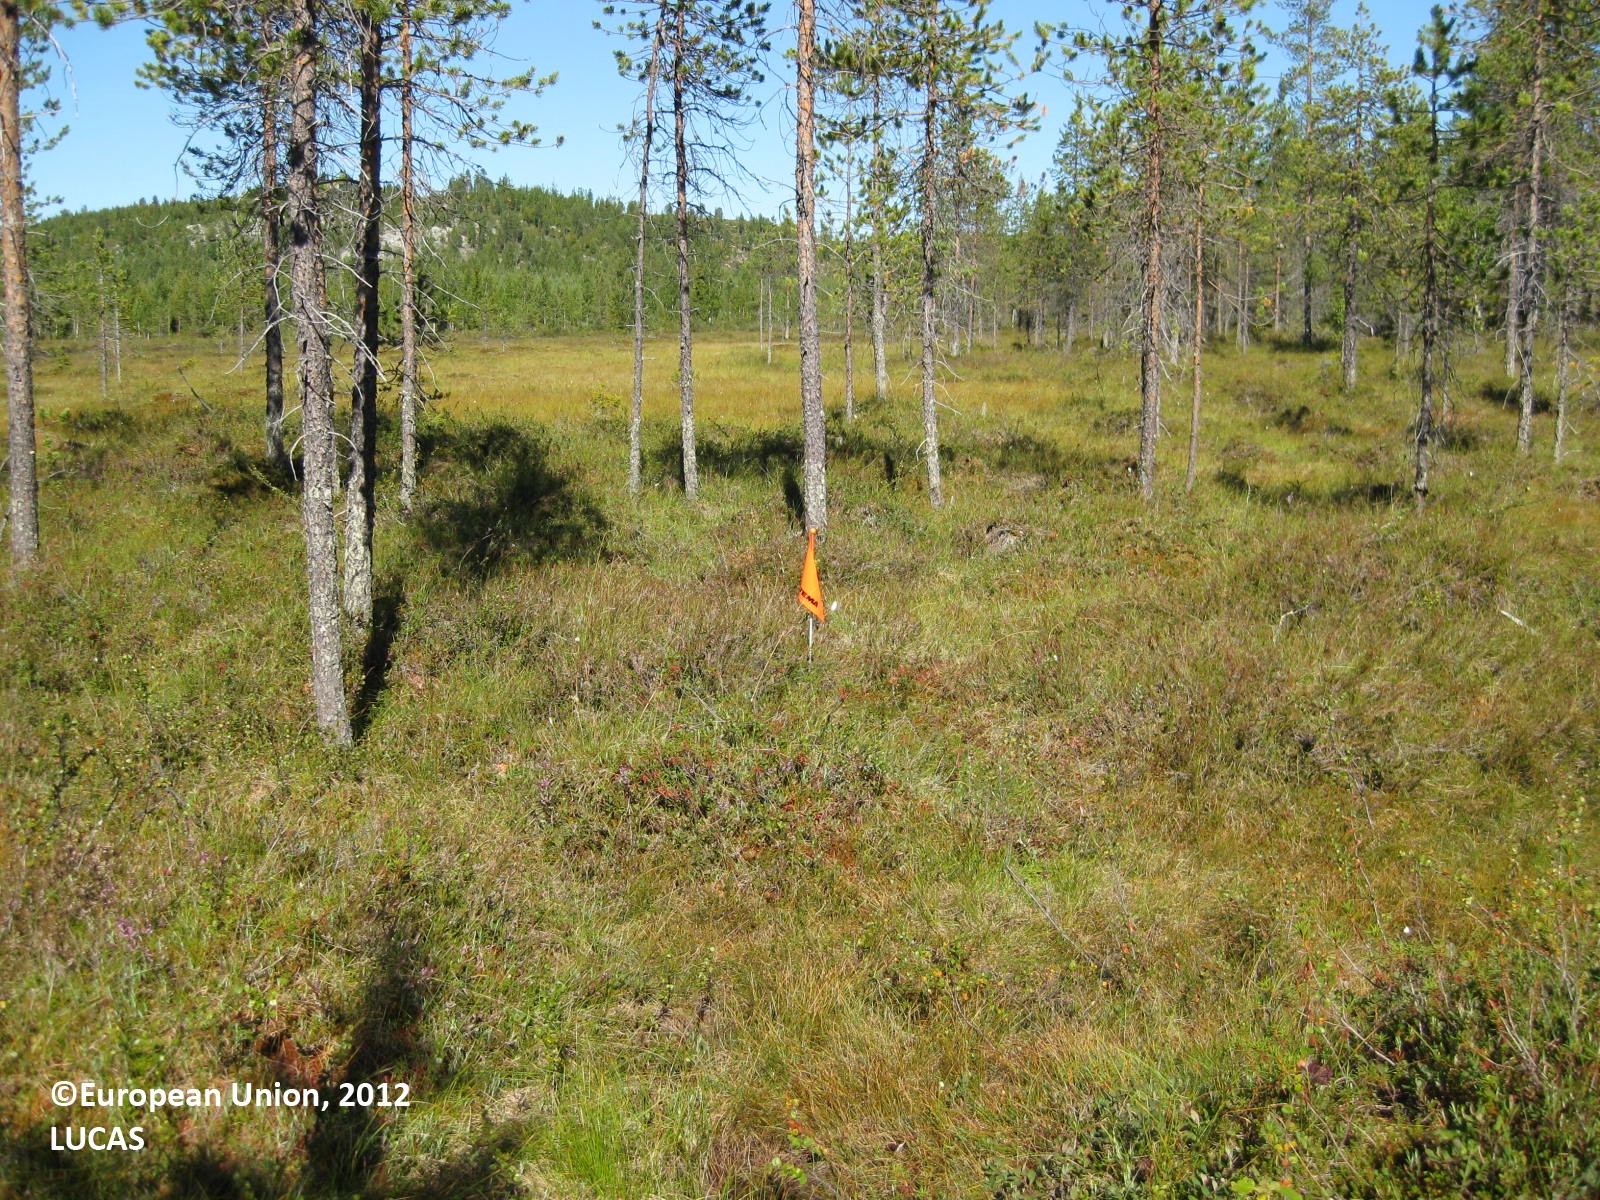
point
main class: Woodland
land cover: Pine dominated coniferous woodland
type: boreal forest
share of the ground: 25 - 50 %
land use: Forestry
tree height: > 5 m
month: August
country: FI
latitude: 66.4311
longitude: 28.5489
